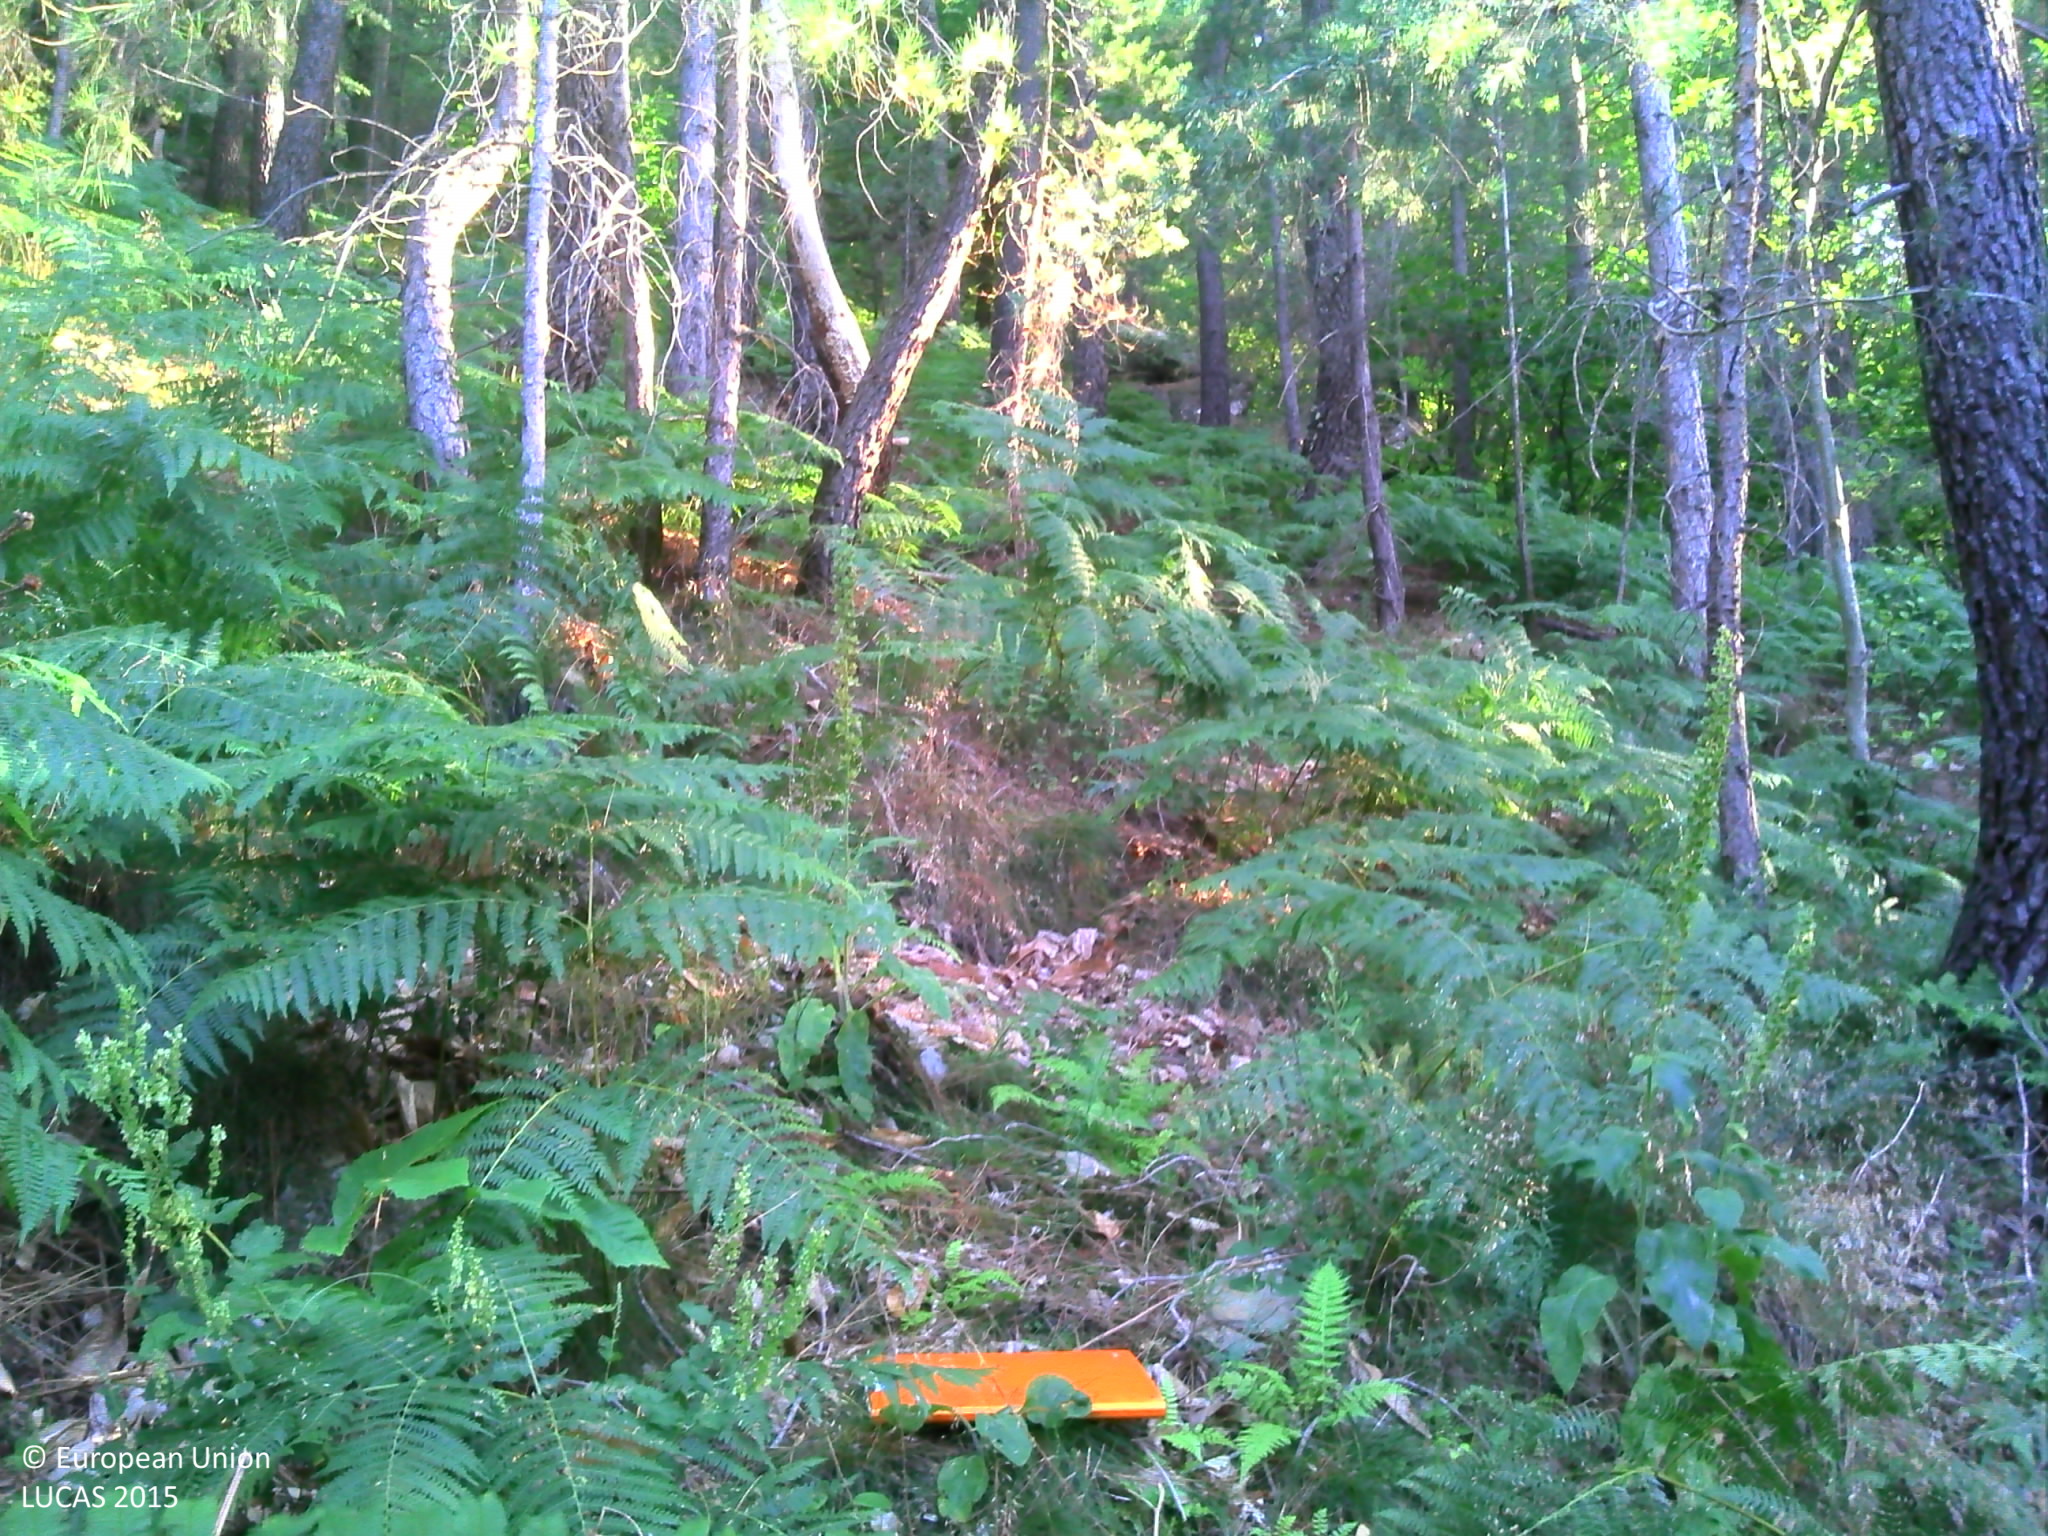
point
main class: Woodland
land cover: Pine dominated mixed woodland
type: coniferous forest of the mediterranean region
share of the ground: > 75 %
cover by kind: broadleaved forest trees 75 %, coniferous forest trees 25 %
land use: Forestry
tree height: > 5 m
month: June
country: FR
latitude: 44.2633
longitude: 3.9315
